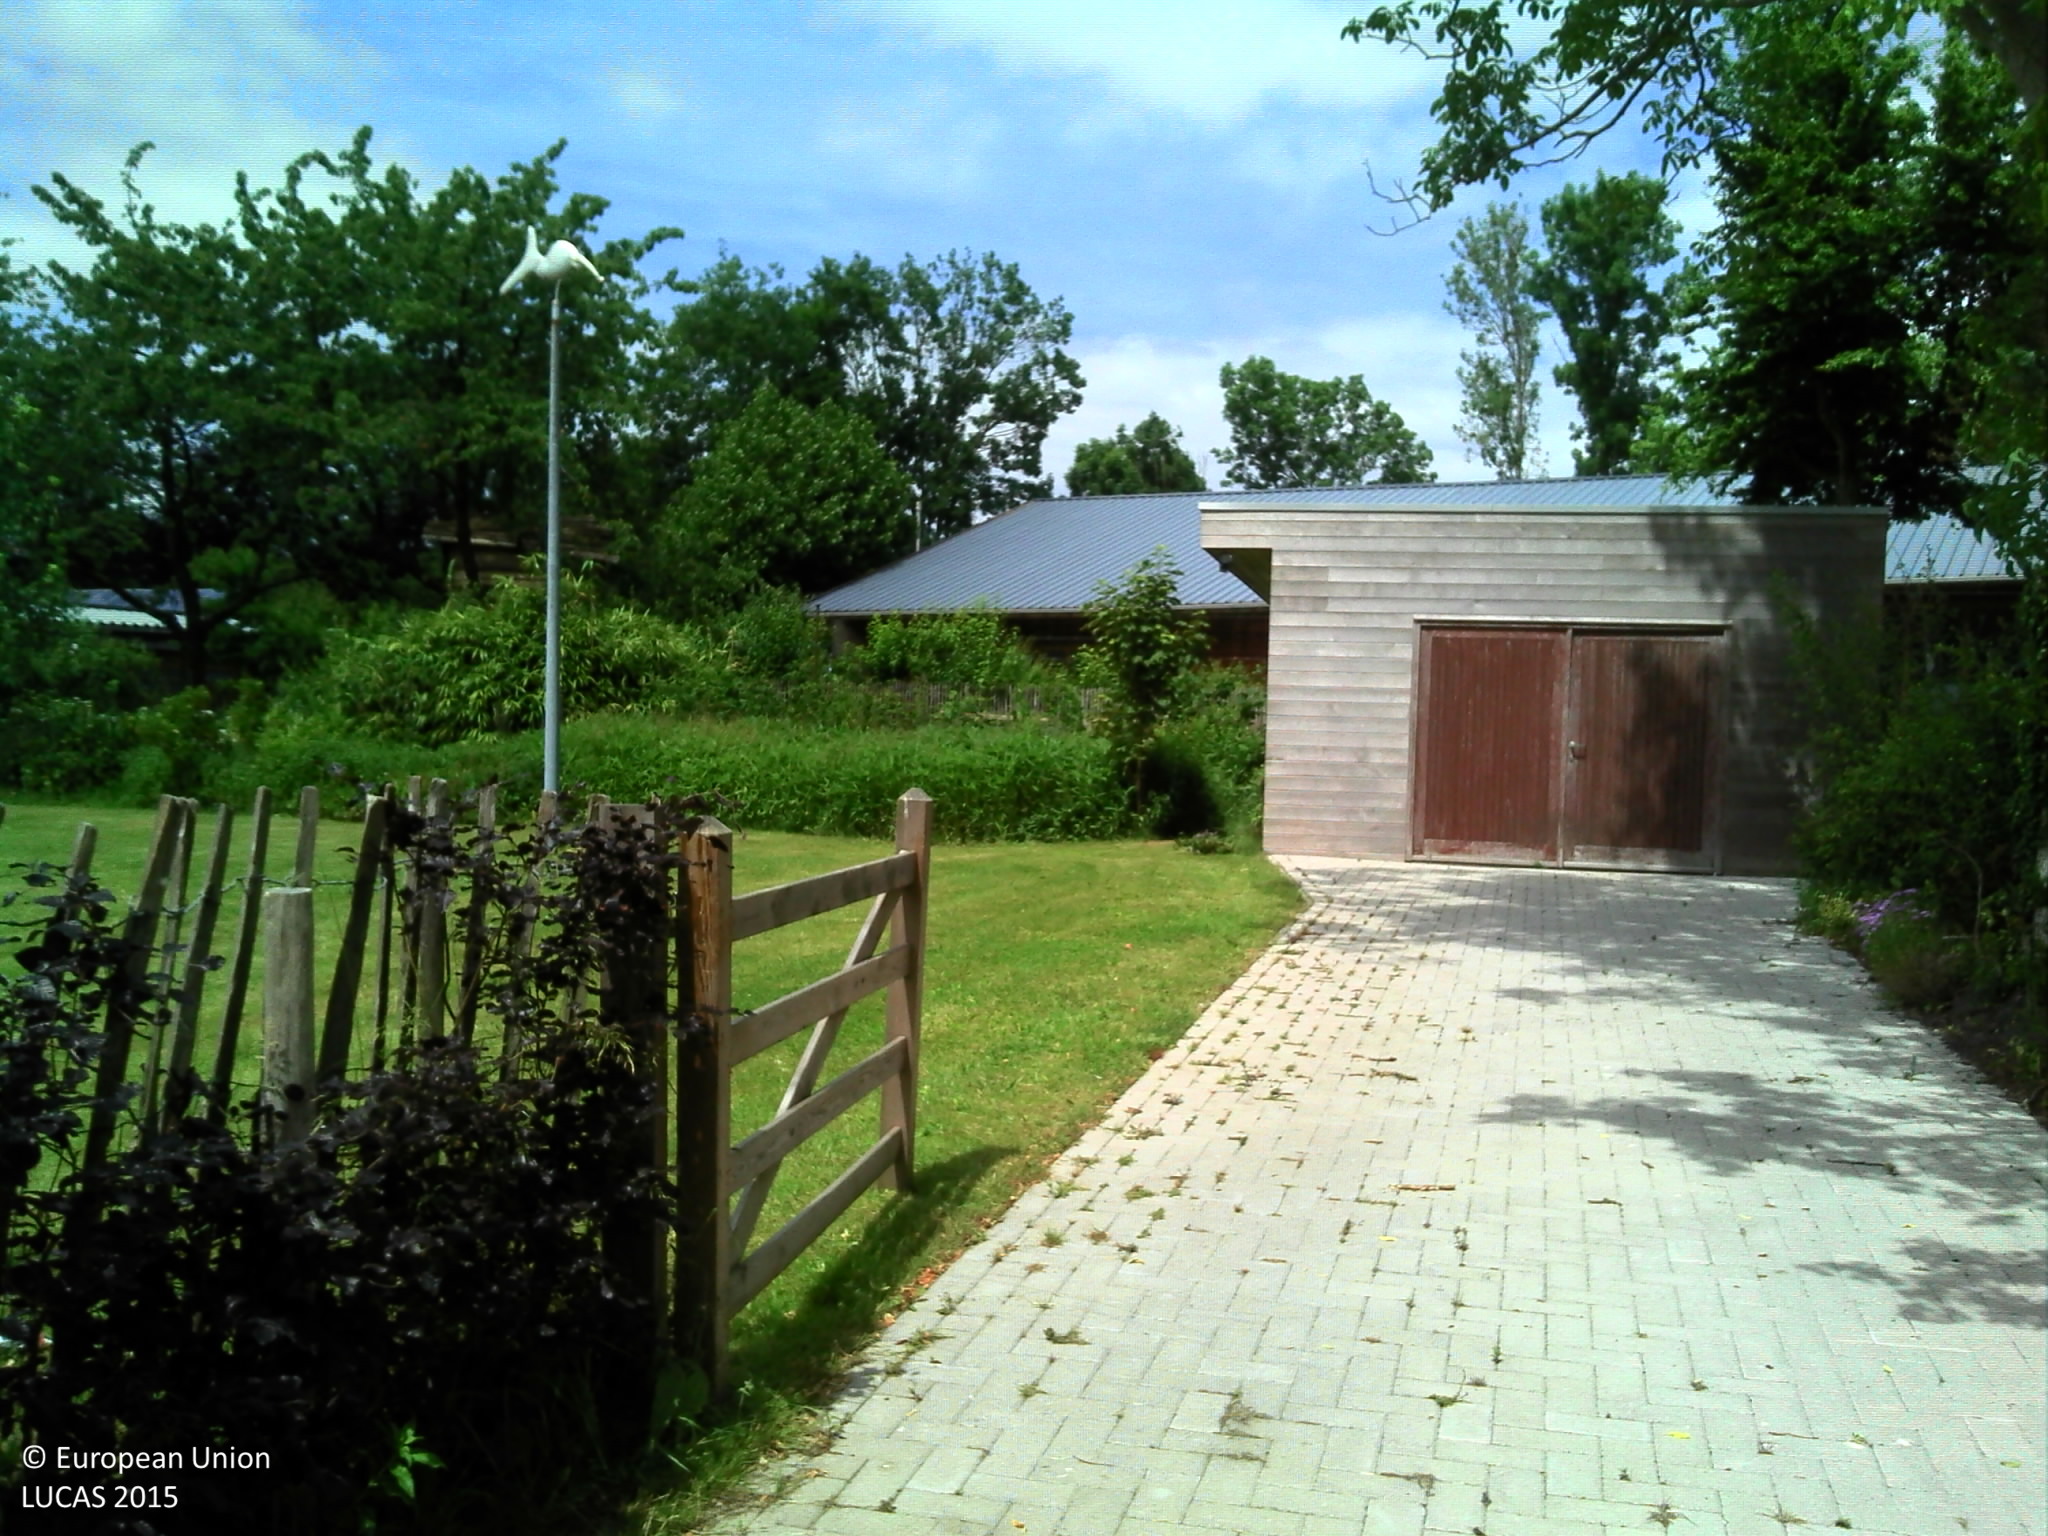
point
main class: Grassland
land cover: Grassland with sparse tree/shrub cover
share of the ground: > 75 %
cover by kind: herbaceous plants 95 %, broadleaved forest trees 5 %
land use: Residential
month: June
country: BE
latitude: 51.2304
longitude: 4.2810
